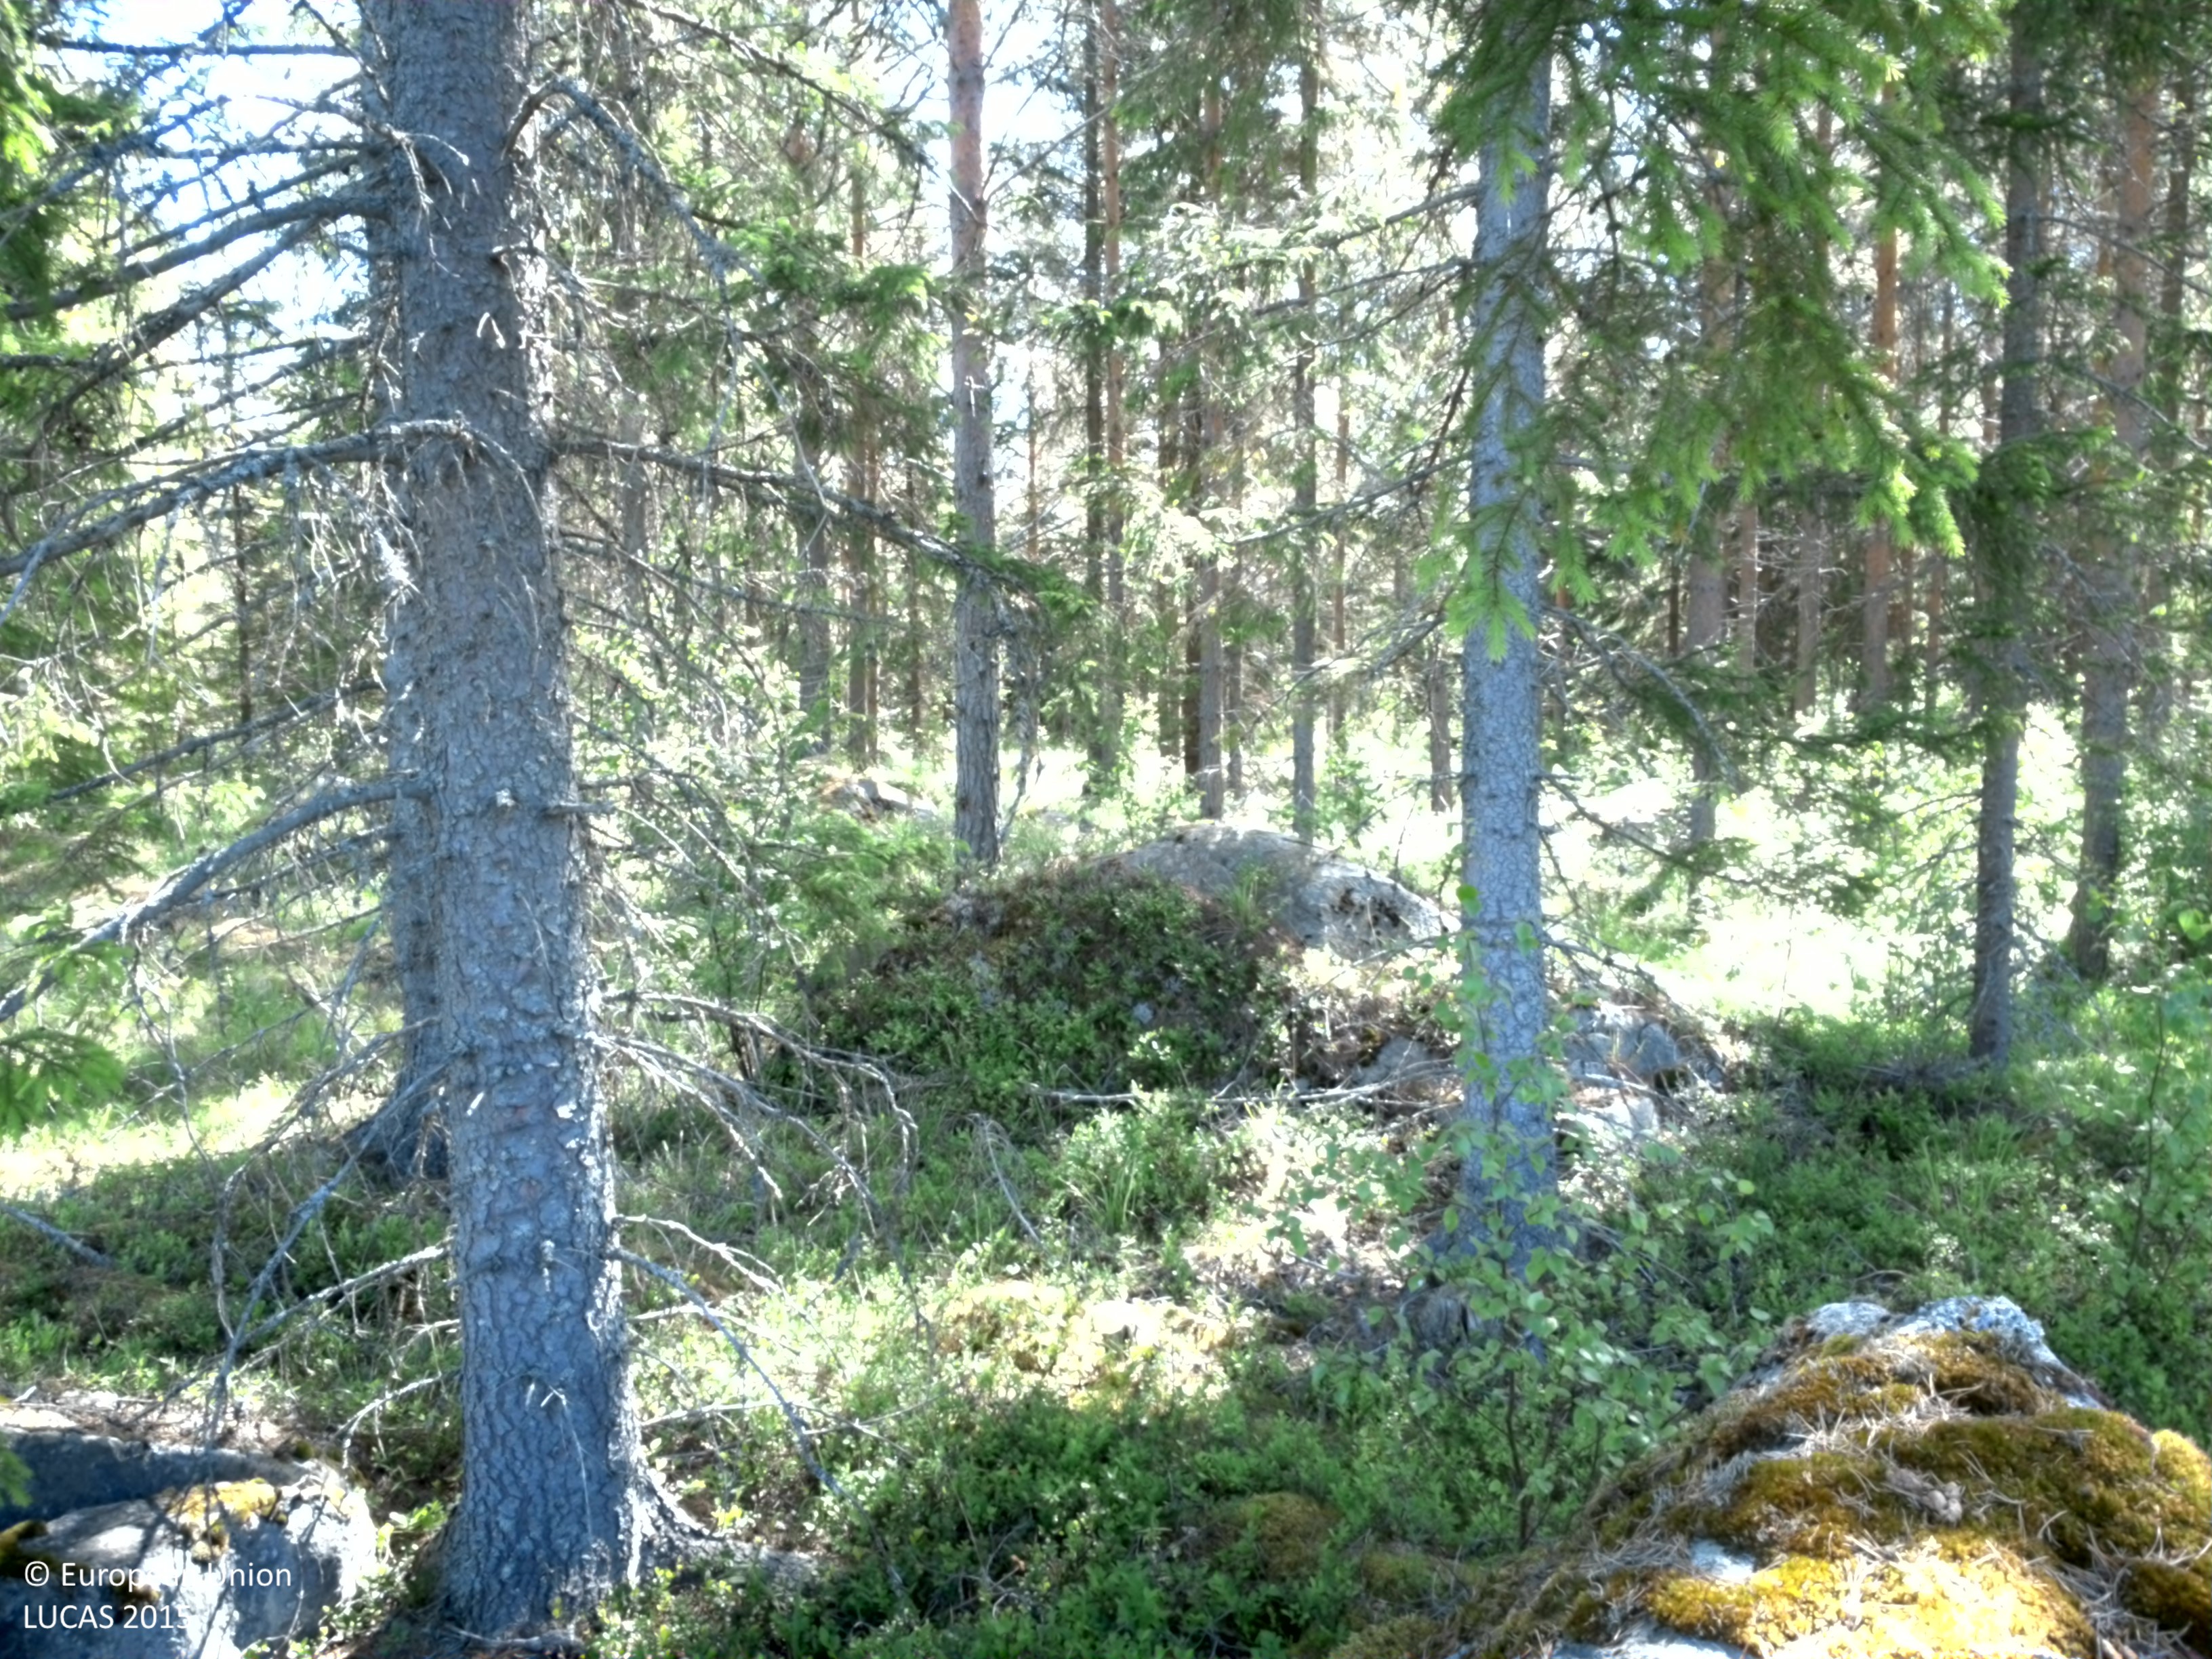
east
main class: Woodland
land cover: Spruce dominated mixed woodland
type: boreal forest
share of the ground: 50 - 75 %
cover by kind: coniferous forest trees 45 %, herbaceous plants 30 %, broadleaved forest trees 15 %, lichens and mosses 10 %
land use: Forestry
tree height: > 5 m
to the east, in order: Spruce dominated mixed woodland; Pine dominated coniferous woodland; Tracks; Pine dominated coniferous woodland; Ditches and canals; Spruce dominated coniferous woodland; Pine dominated mixed woodland; Broadleaved woodland
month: June
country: SE
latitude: 60.2554
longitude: 17.0922
